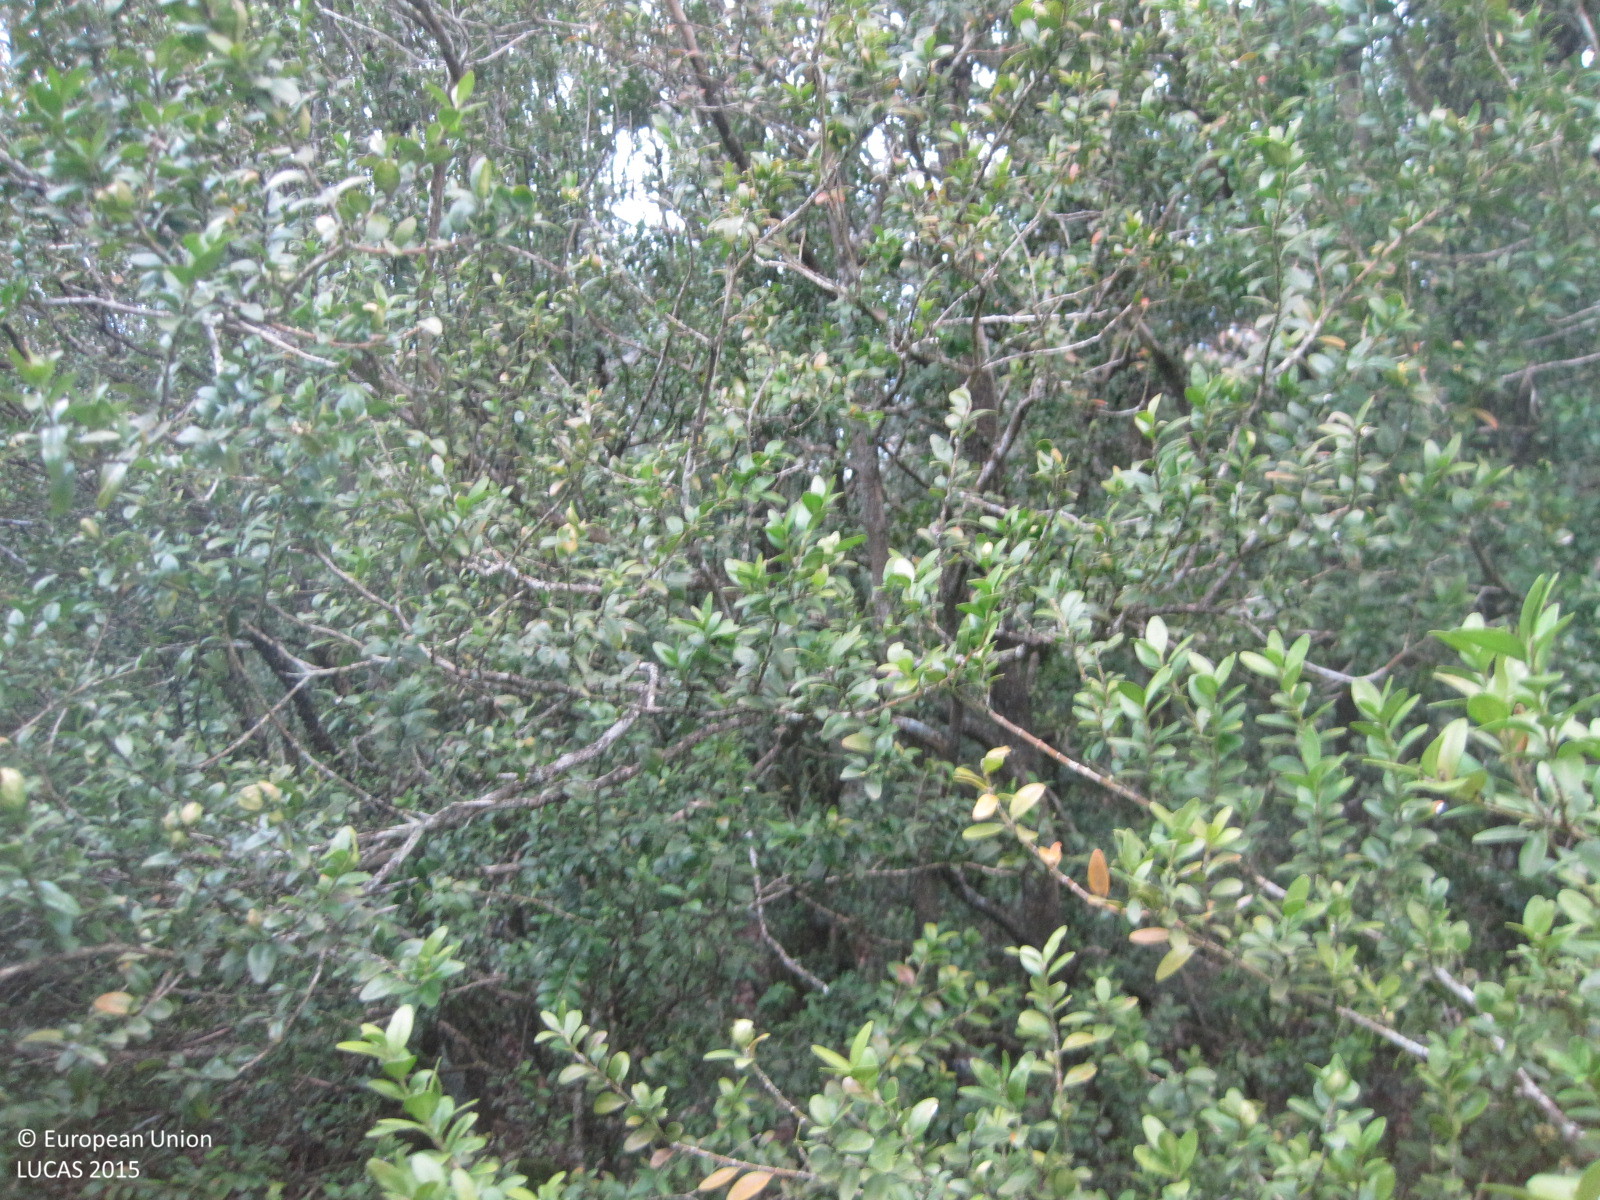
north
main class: Woodland
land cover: Broadleaved woodland
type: broadleaved evergreen forest
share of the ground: > 75 %
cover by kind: shrubs 60 %, broadleaved forest trees 40 %
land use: Semi-natural and natural areas not in use
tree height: > 5 m
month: April
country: ES
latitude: 42.7198
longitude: -2.1699
